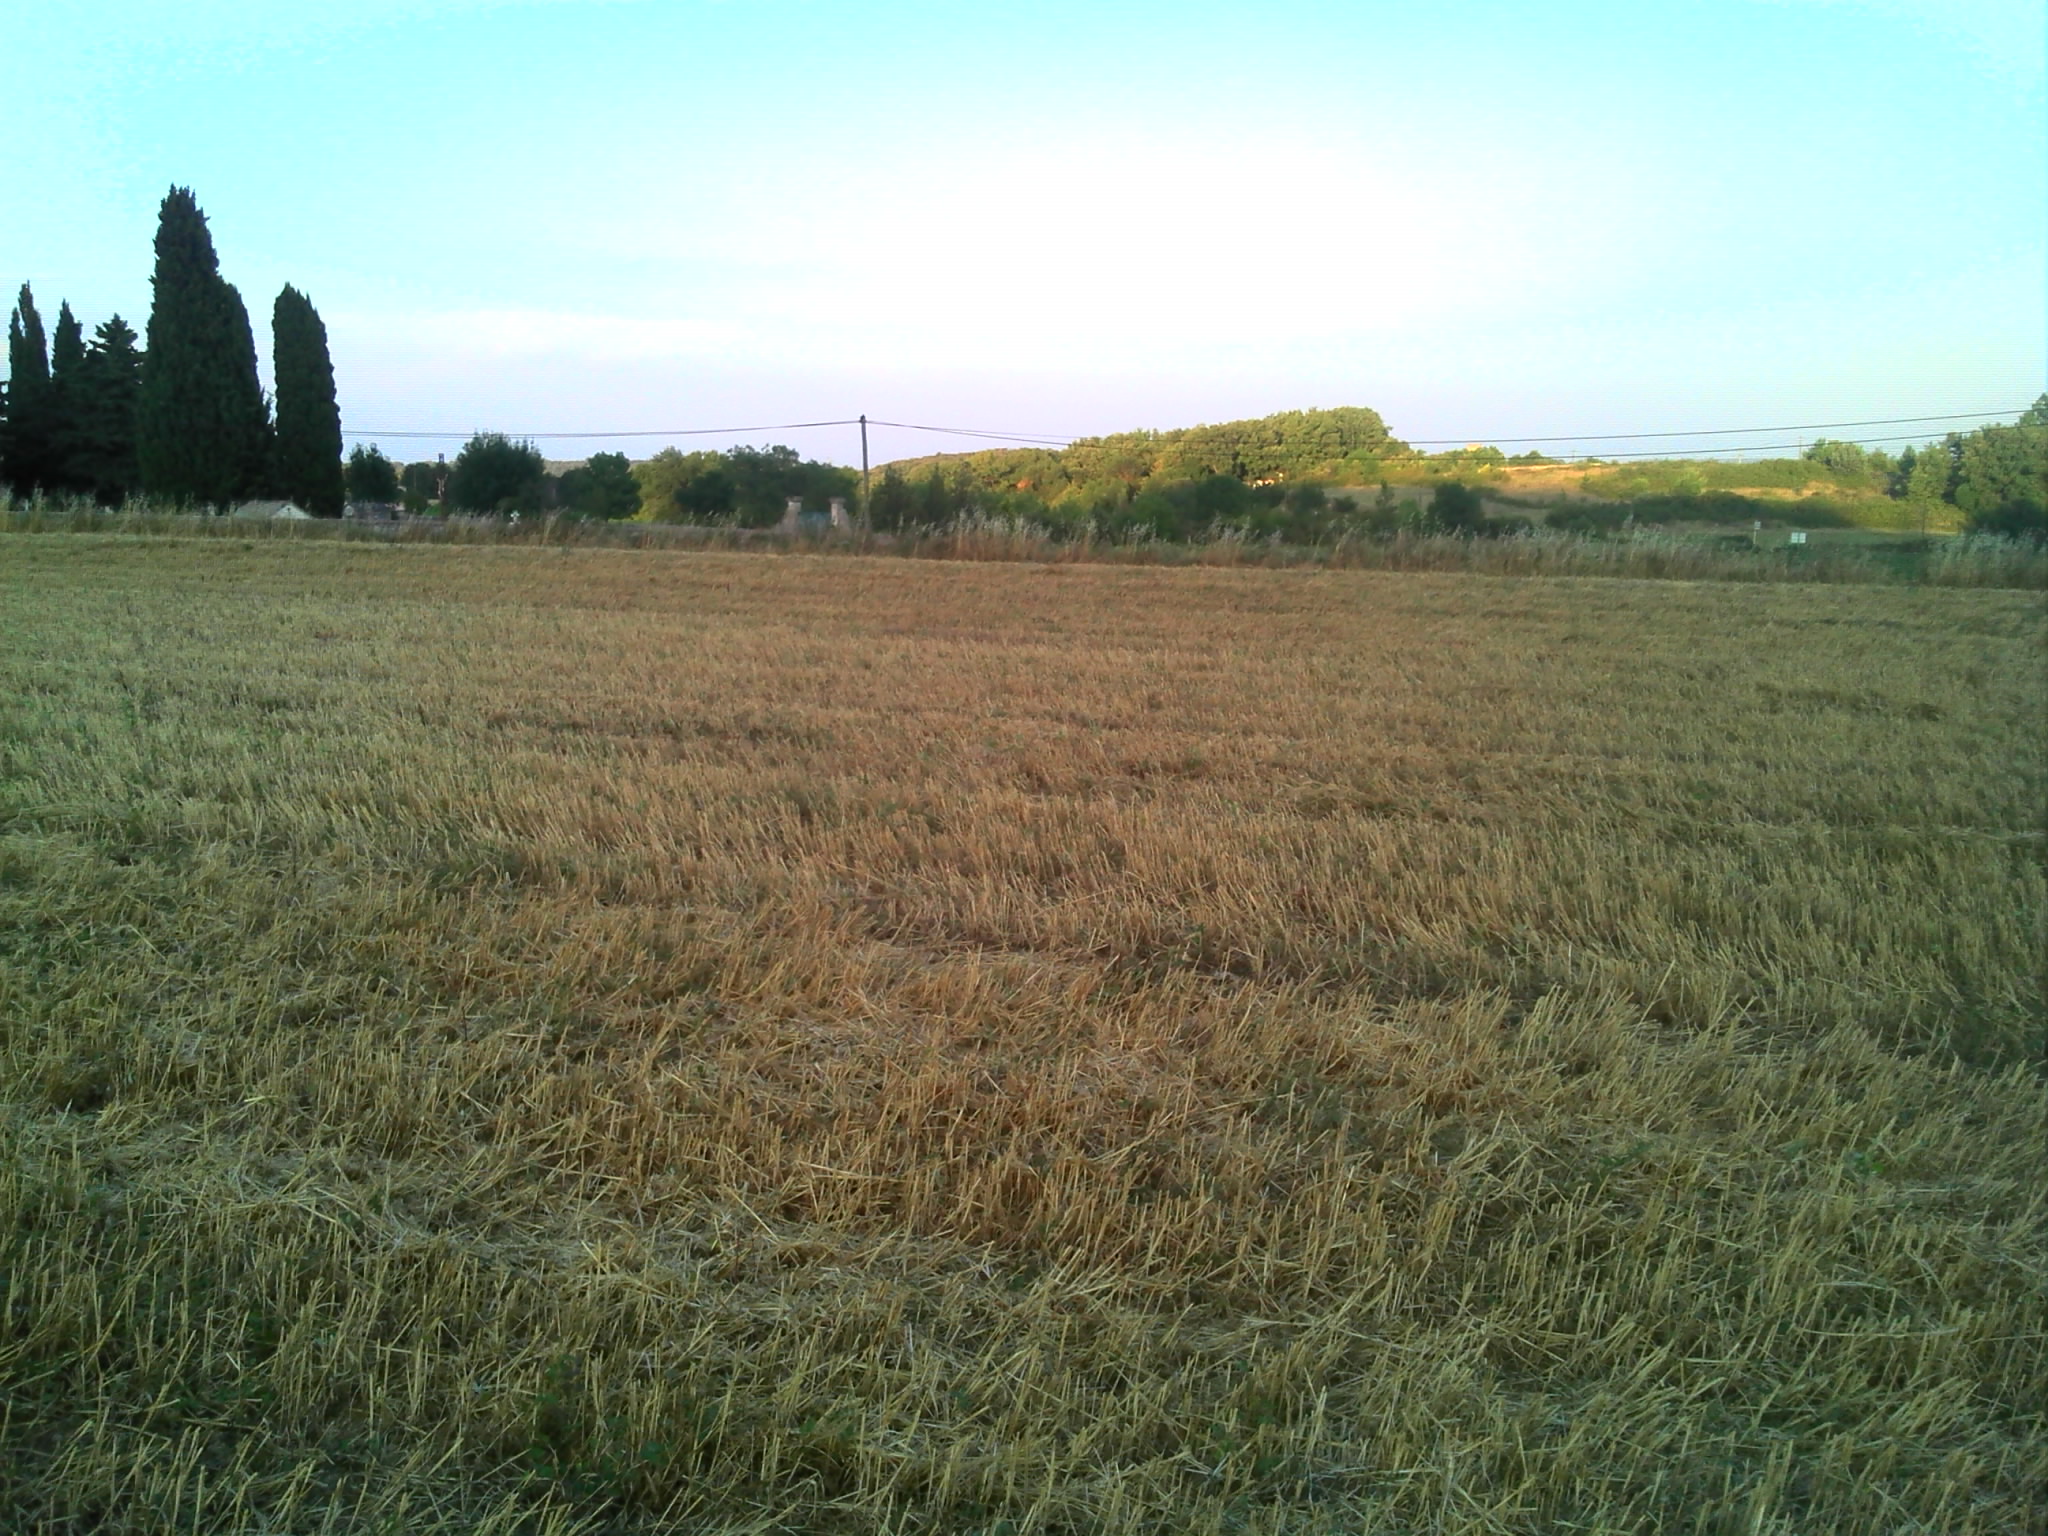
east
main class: Cropland
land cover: Common wheat
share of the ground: 10 - 25 %
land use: Agriculture (excluding fallow land and kitchen gardens)
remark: Harvested field
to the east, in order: Common wheat; Grass margins; Electric lines; Dry stone walls; Ditches and canals; Grass margins; Paved roads, cycling and walking lanes; Ditches and canals; Grass margins; Other bare soil; Vineyards; Artificial constructions in urban areas; Grassland without tree/shrub cover; Broadleaved woodland; Grass margins; Tracks; Broadleaved woodland; Electric lines; Paved roads, cycling and walking lanes; Common wheat
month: July
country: FR
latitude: 43.9938
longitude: 3.9601
